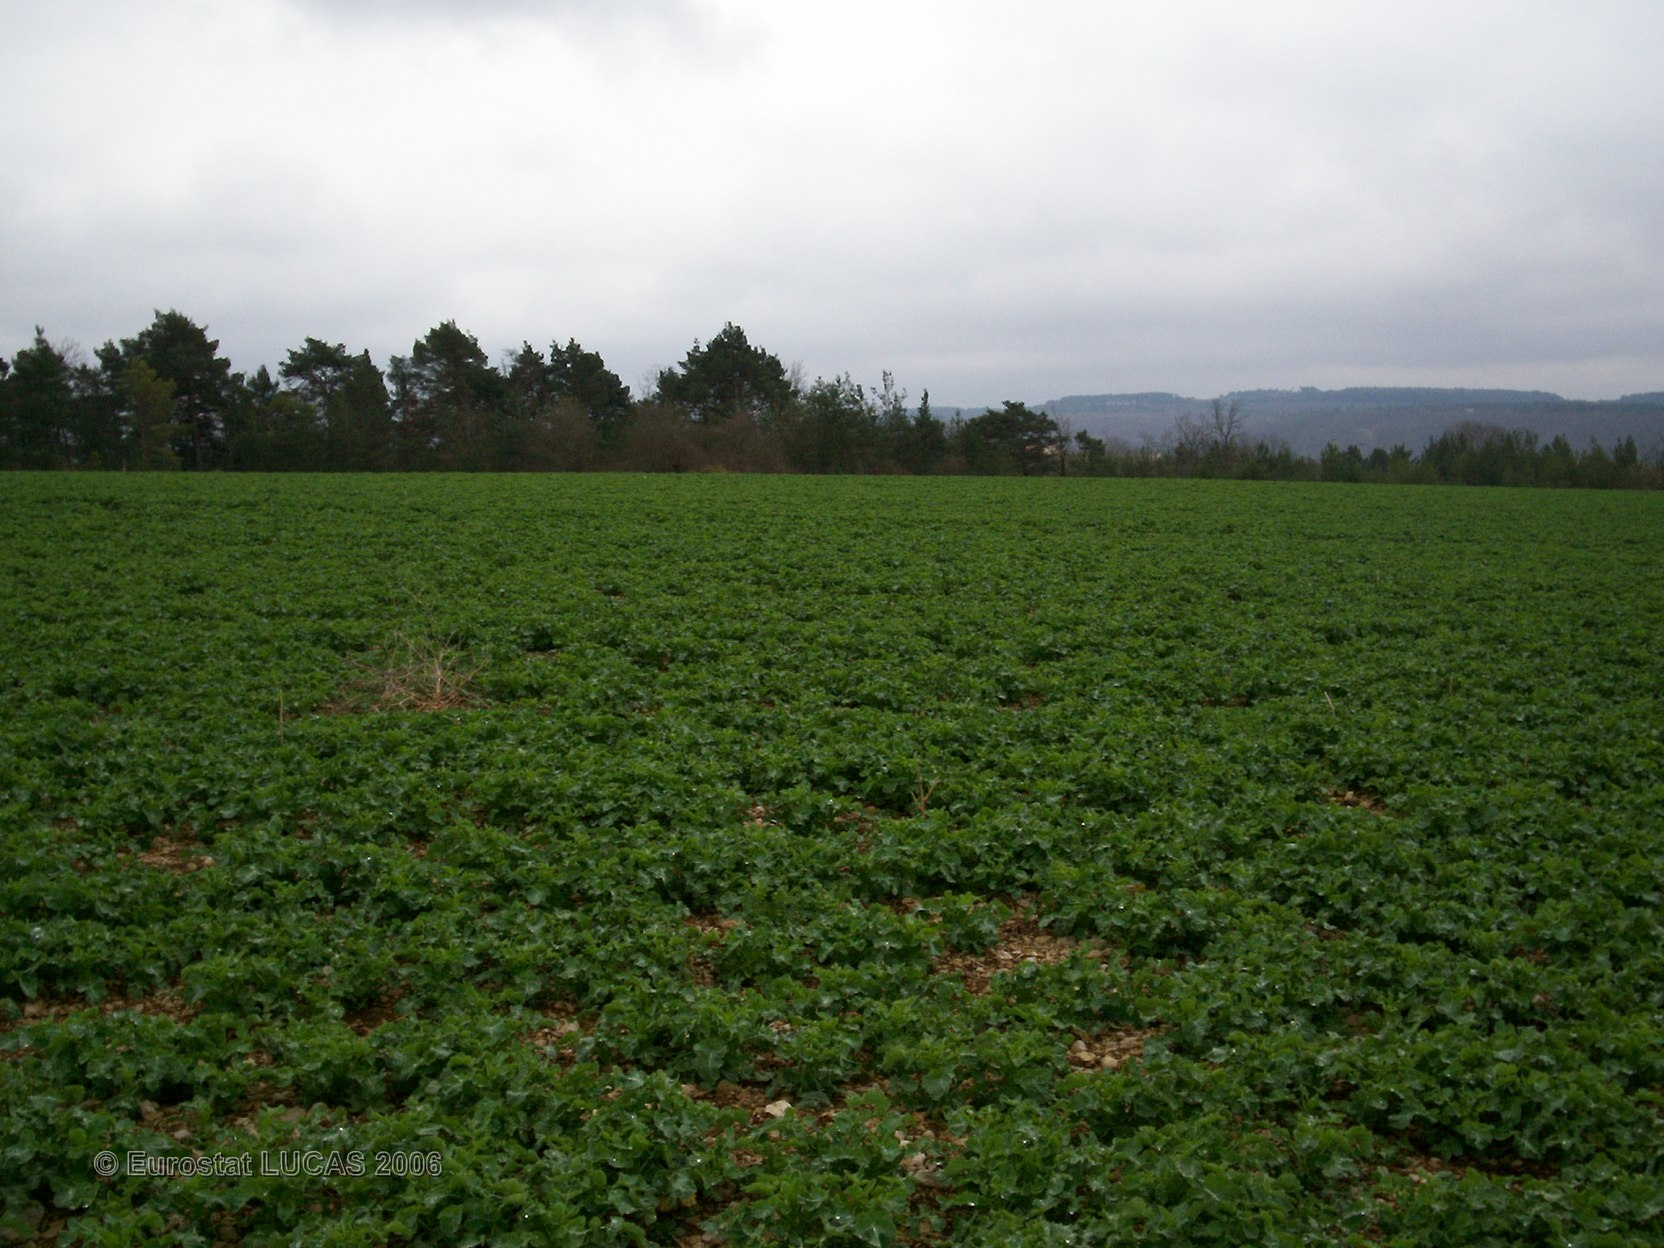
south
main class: Cropland
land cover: Rape and turnip rape
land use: Agriculture (excluding fallow land and kitchen gardens)
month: April
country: FR
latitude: 48.0687
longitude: 4.5090
